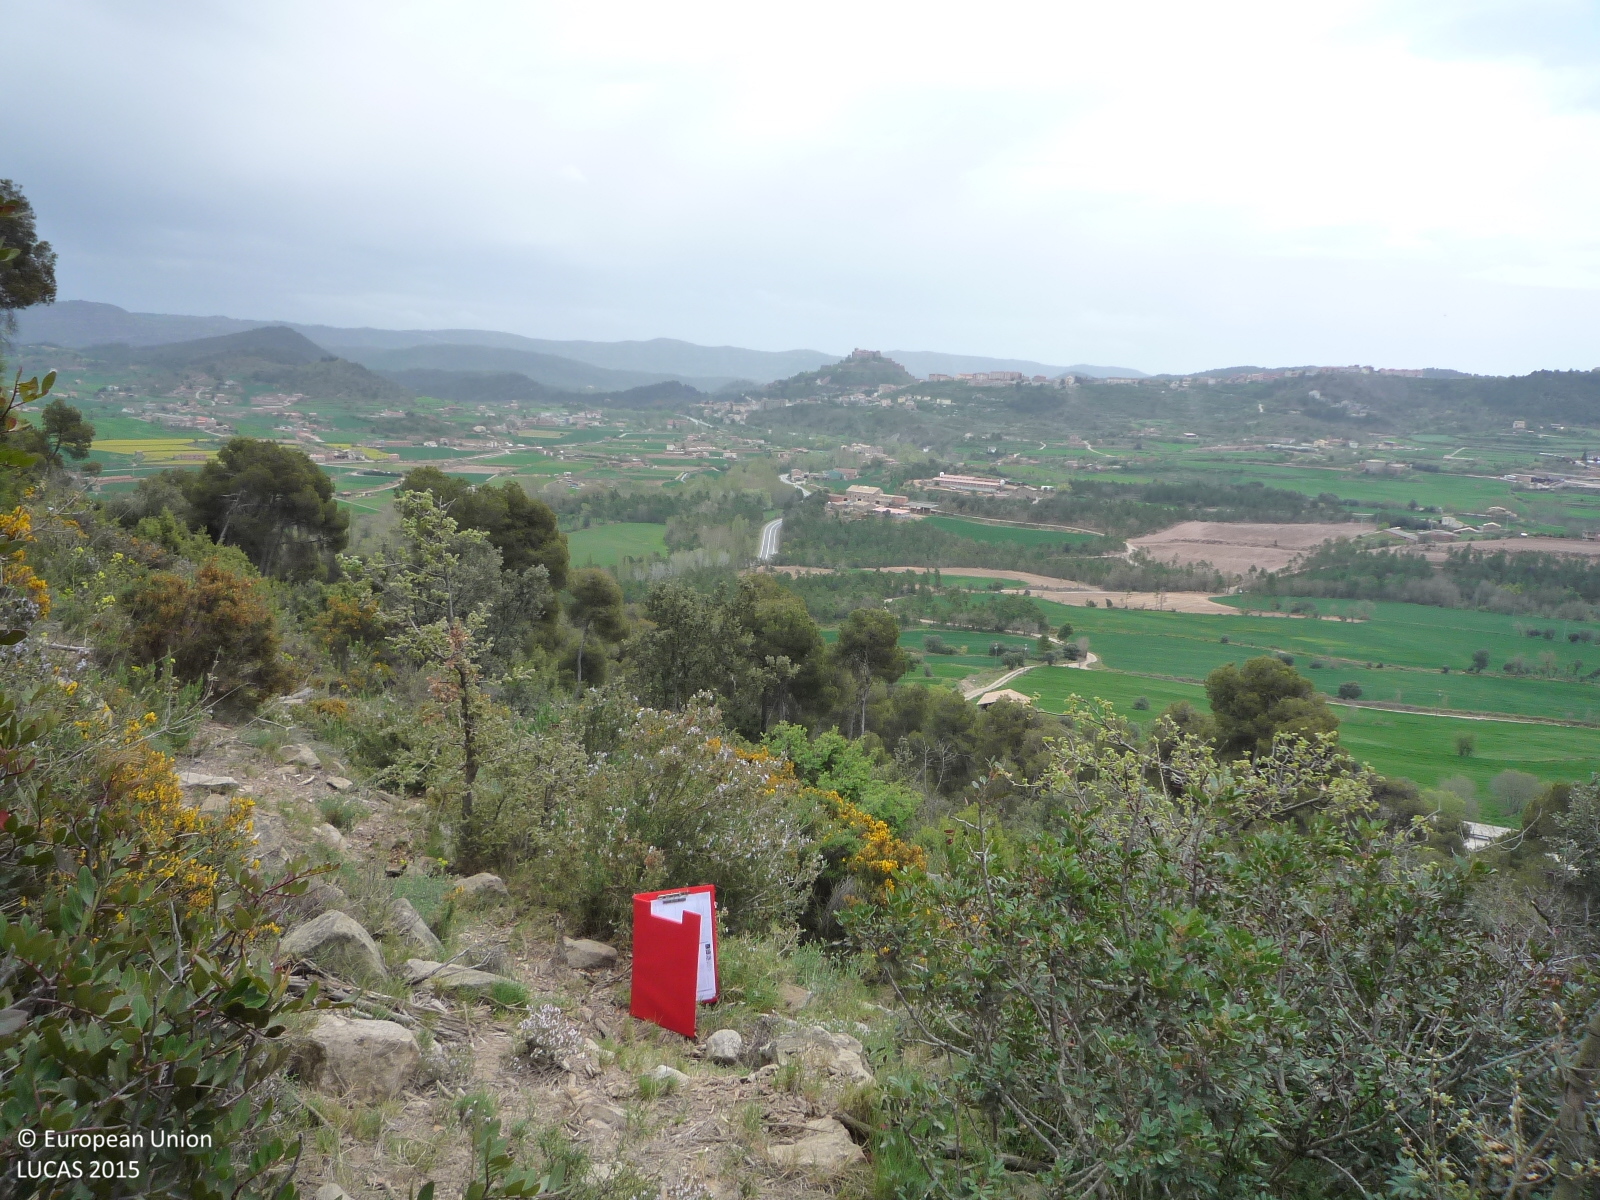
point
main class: Shrubland
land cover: Shrubland without tree cover
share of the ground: > 75 %
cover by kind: shrubs 75 %, lichens and mosses 15 %, herbaceous plants 10 %
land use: Semi-natural and natural areas not in use
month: April
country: ES
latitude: 41.9281
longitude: 1.6564
